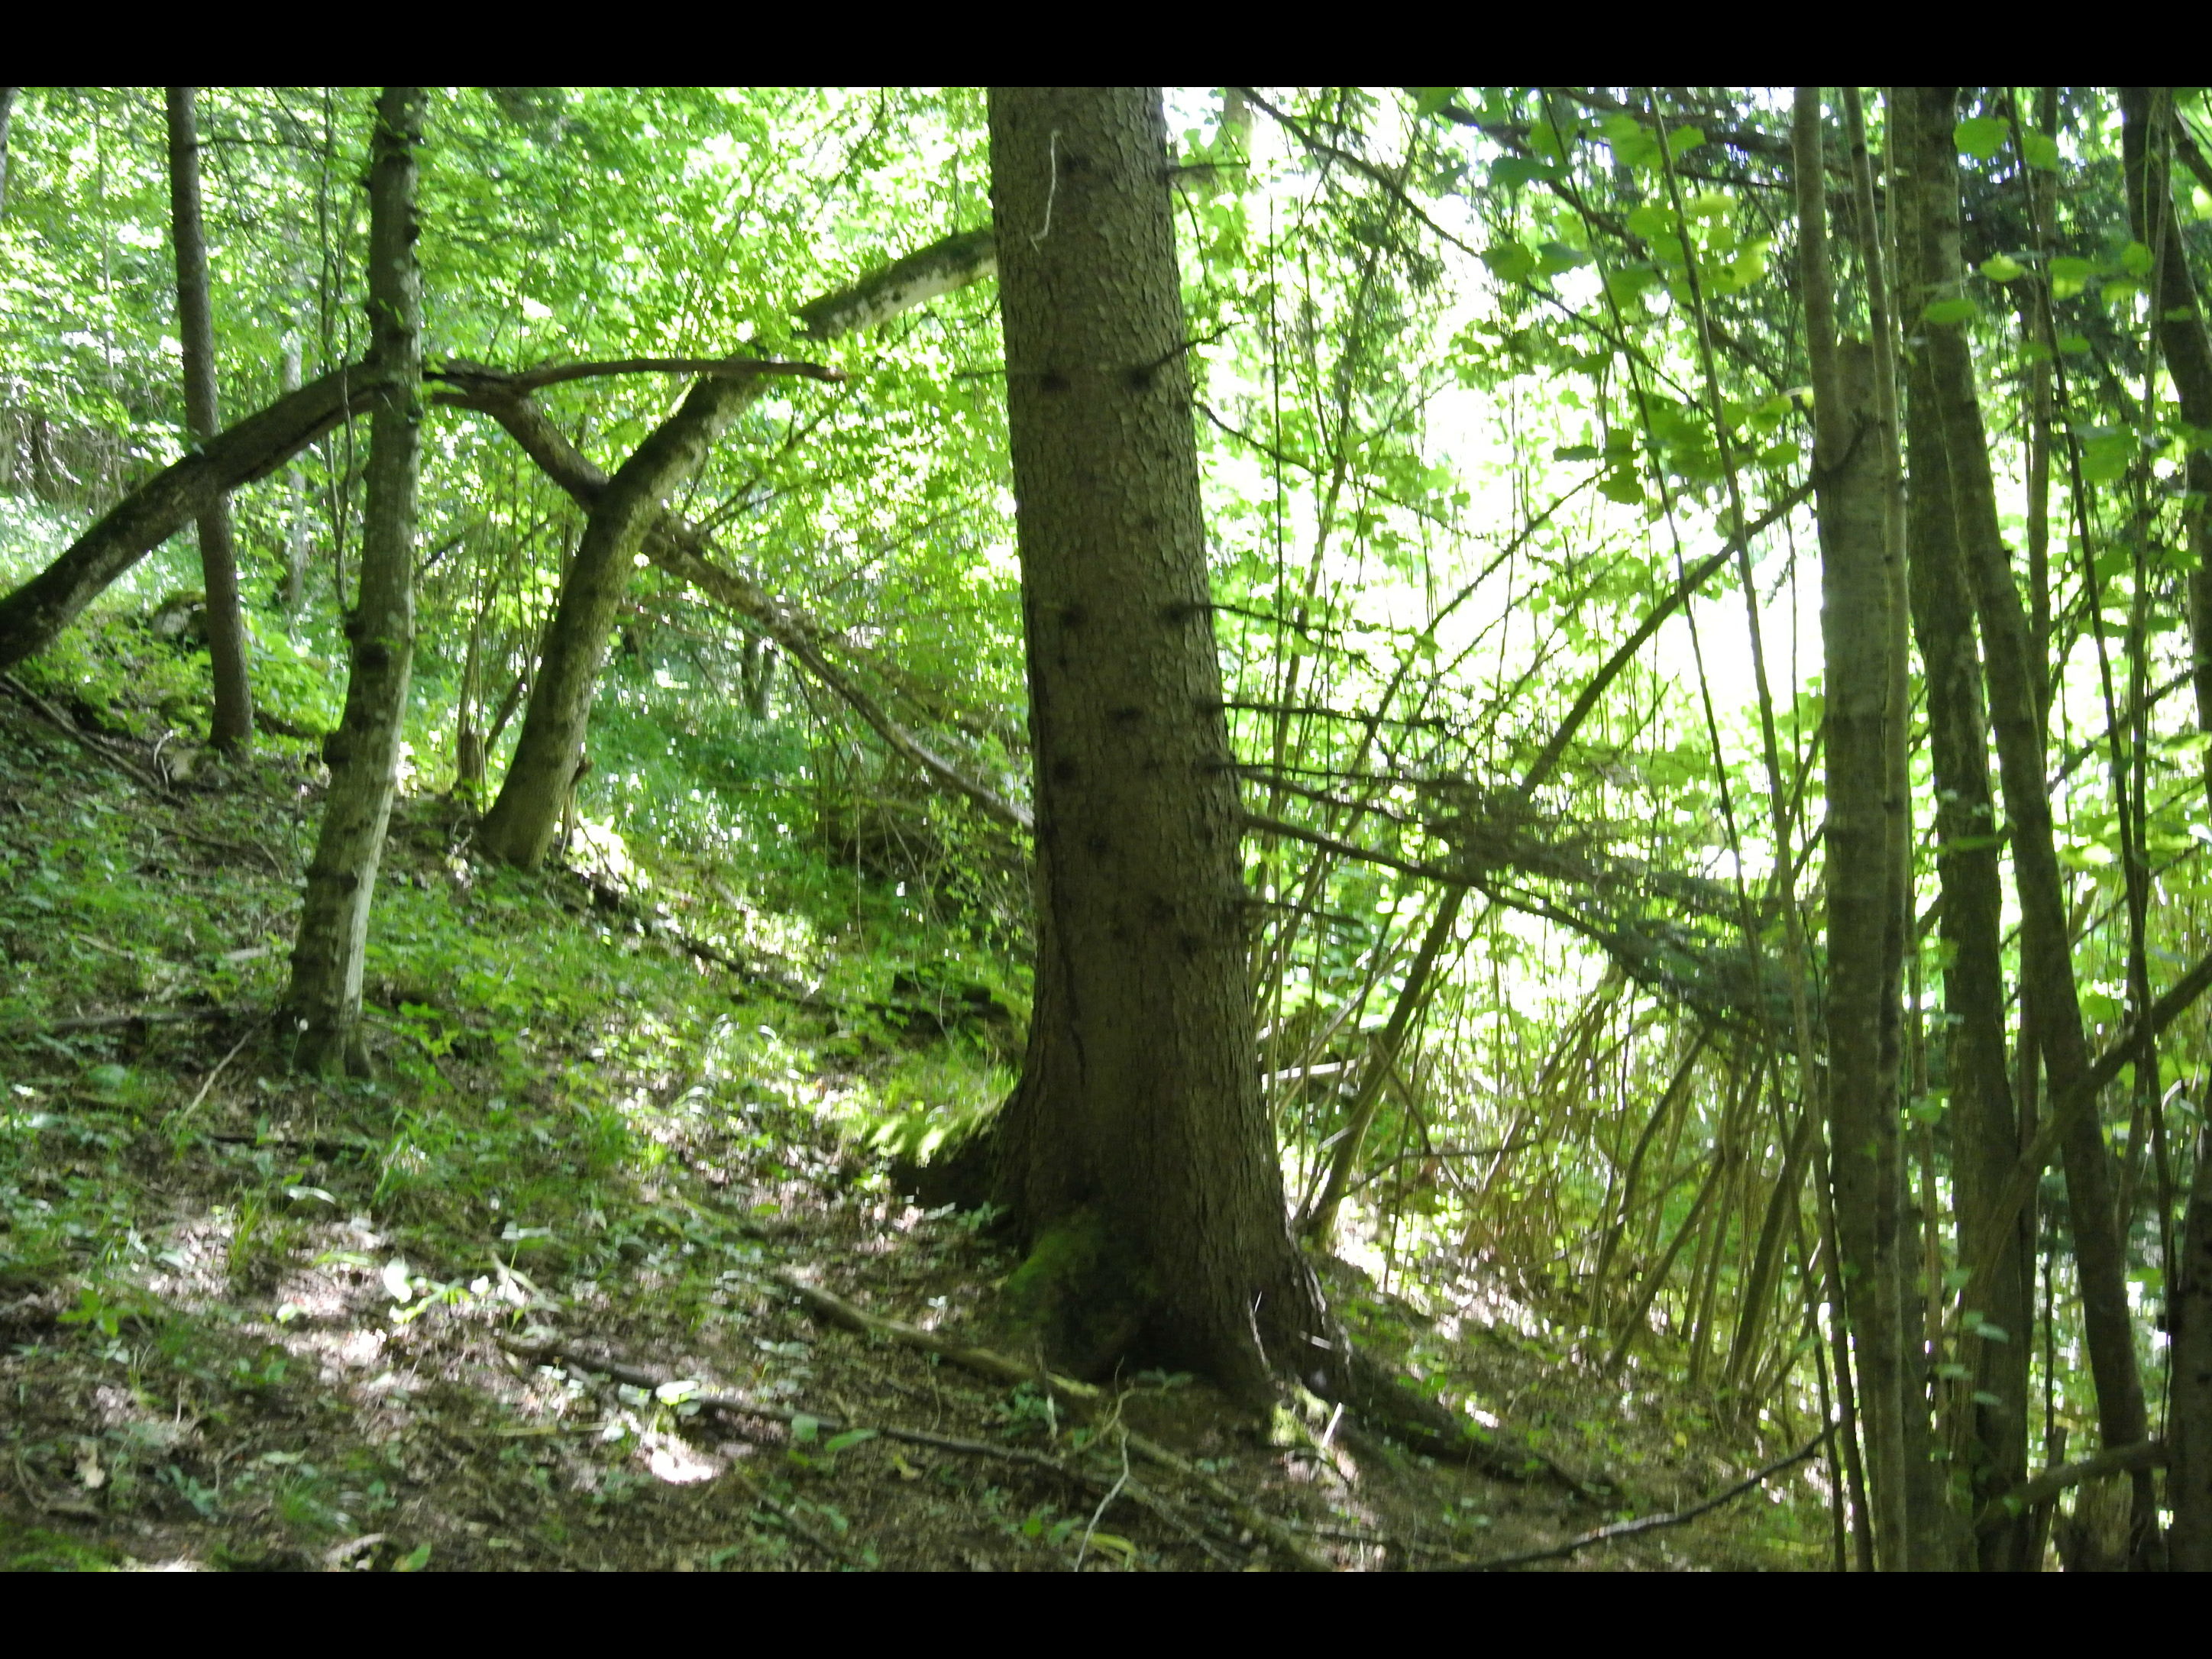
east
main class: Woodland
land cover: Spruce dominated mixed woodland
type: mountainous beech forest
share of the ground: > 75 %
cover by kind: broadleaved forest trees 65 %, coniferous forest trees 35 %
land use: Forestry
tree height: > 5 m
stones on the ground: < 10 %
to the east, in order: Spruce dominated mixed woodland; Broadleaved woodland; Fences; Broadleaved woodland; Spruce dominated mixed woodland; Broadleaved woodland; Grassland with sparse tree/shrub cover; Fences; Spruce dominated coniferous woodland
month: June
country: AT
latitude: 47.9471
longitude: 15.3973
